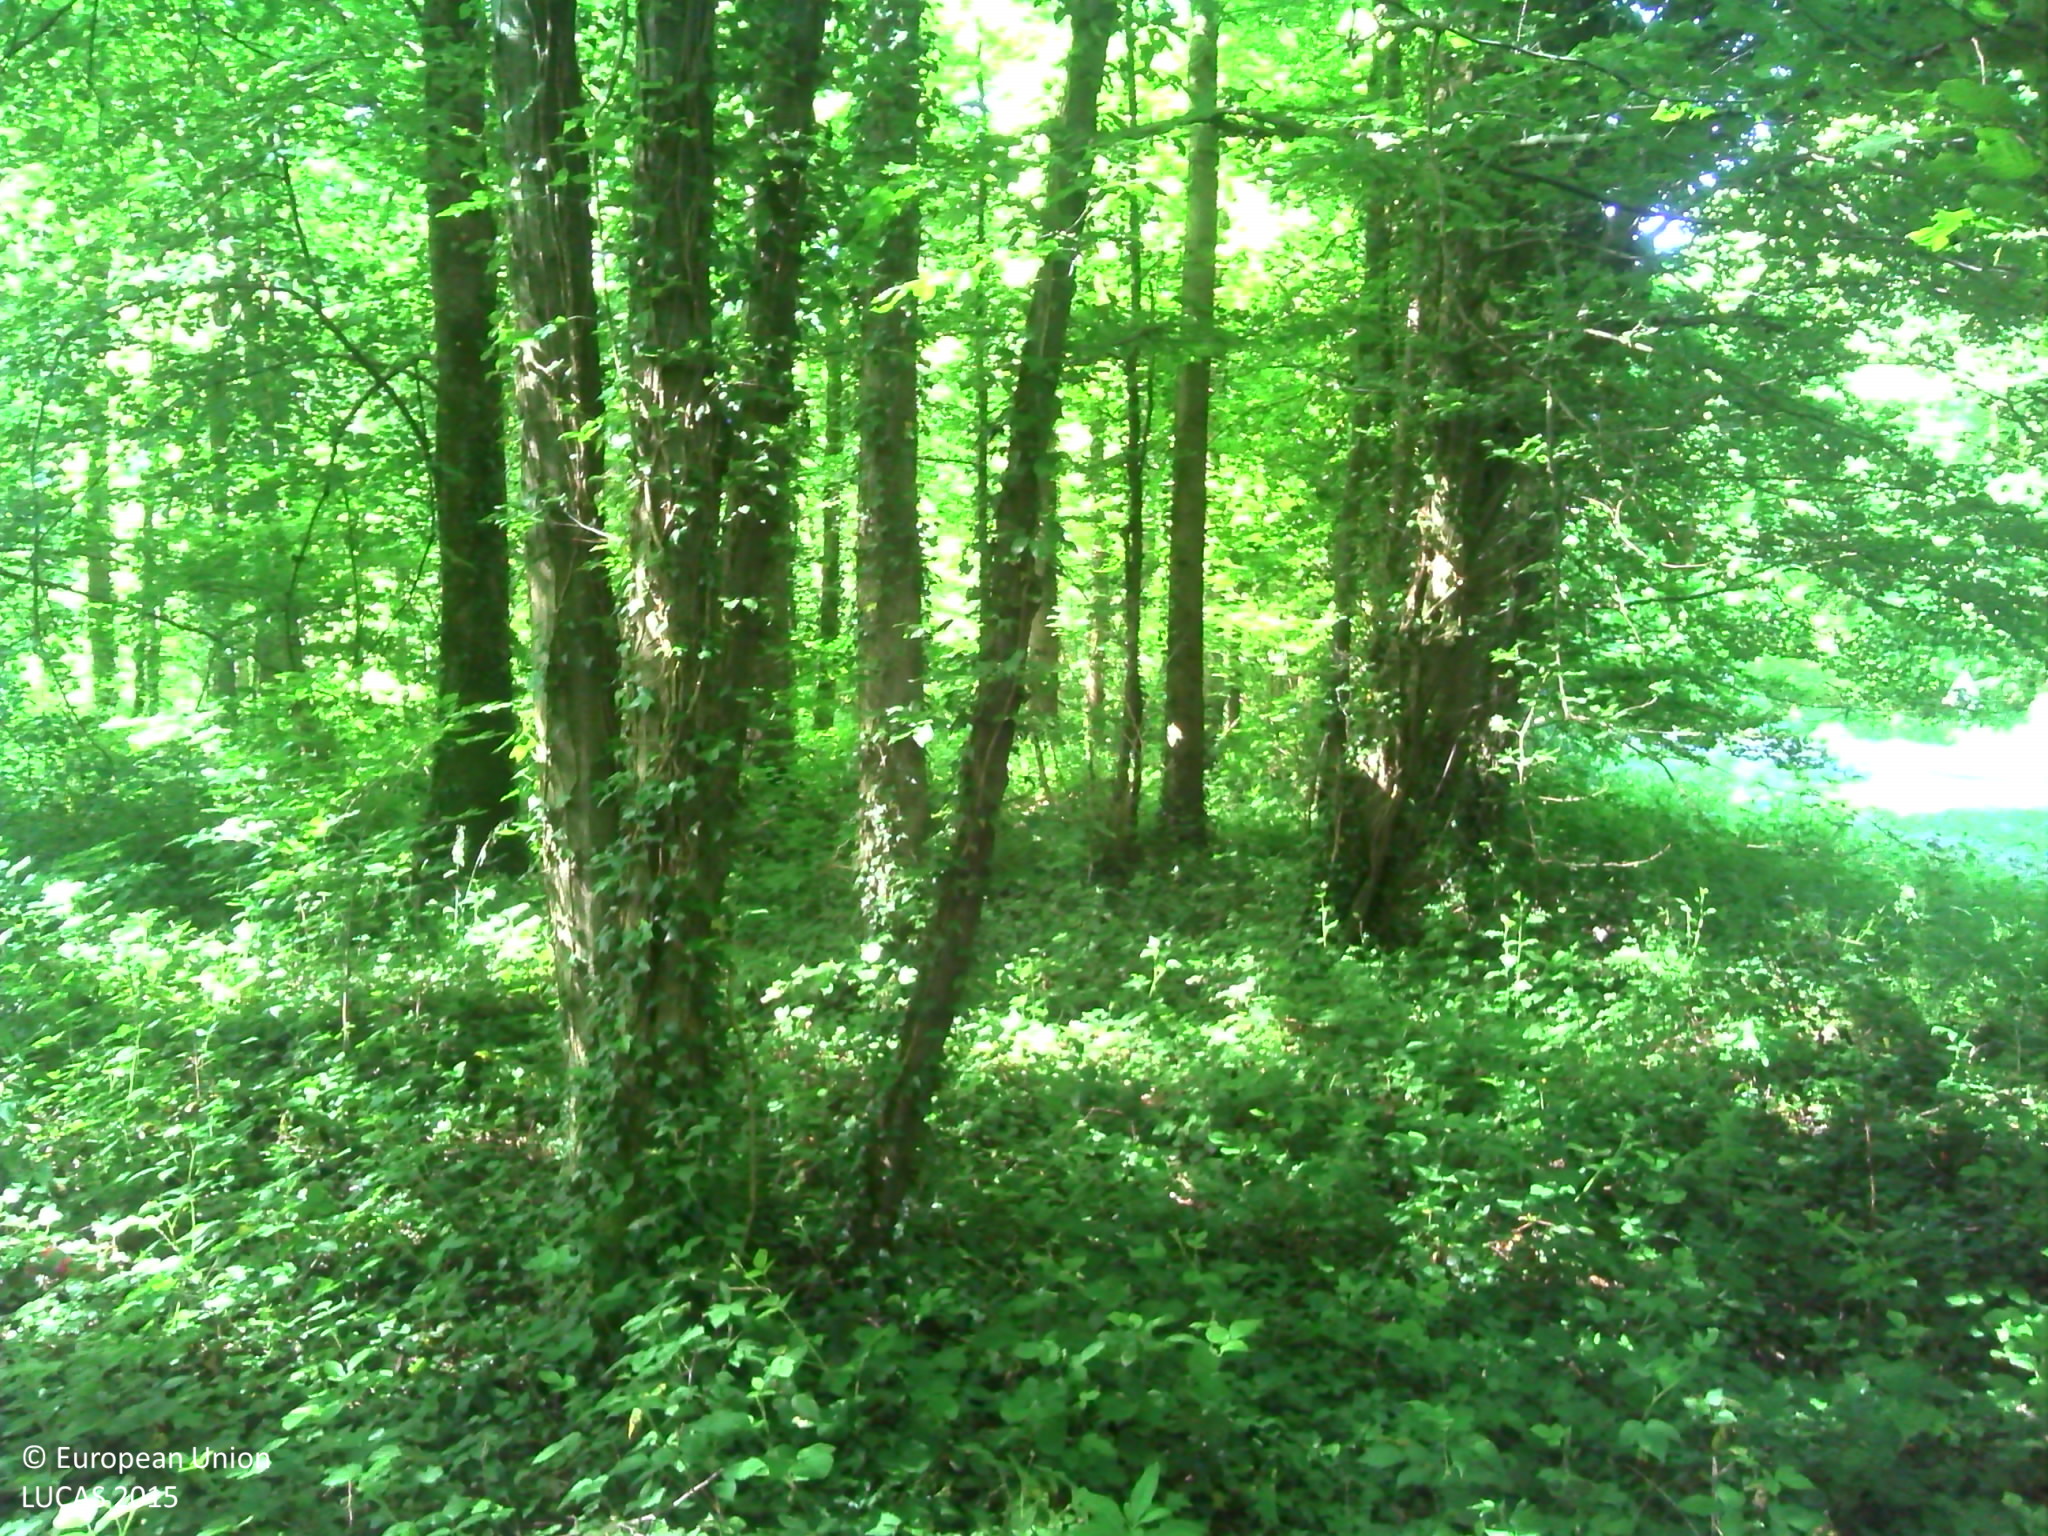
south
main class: Woodland
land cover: Broadleaved woodland
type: mesophytic deciduous forest
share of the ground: > 75 %
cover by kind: broadleaved forest trees 80 %, shrubs 10 %, herbaceous plants 10 %
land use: Forestry
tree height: > 5 m
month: June
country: FR
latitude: 49.9399
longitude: 4.0729
